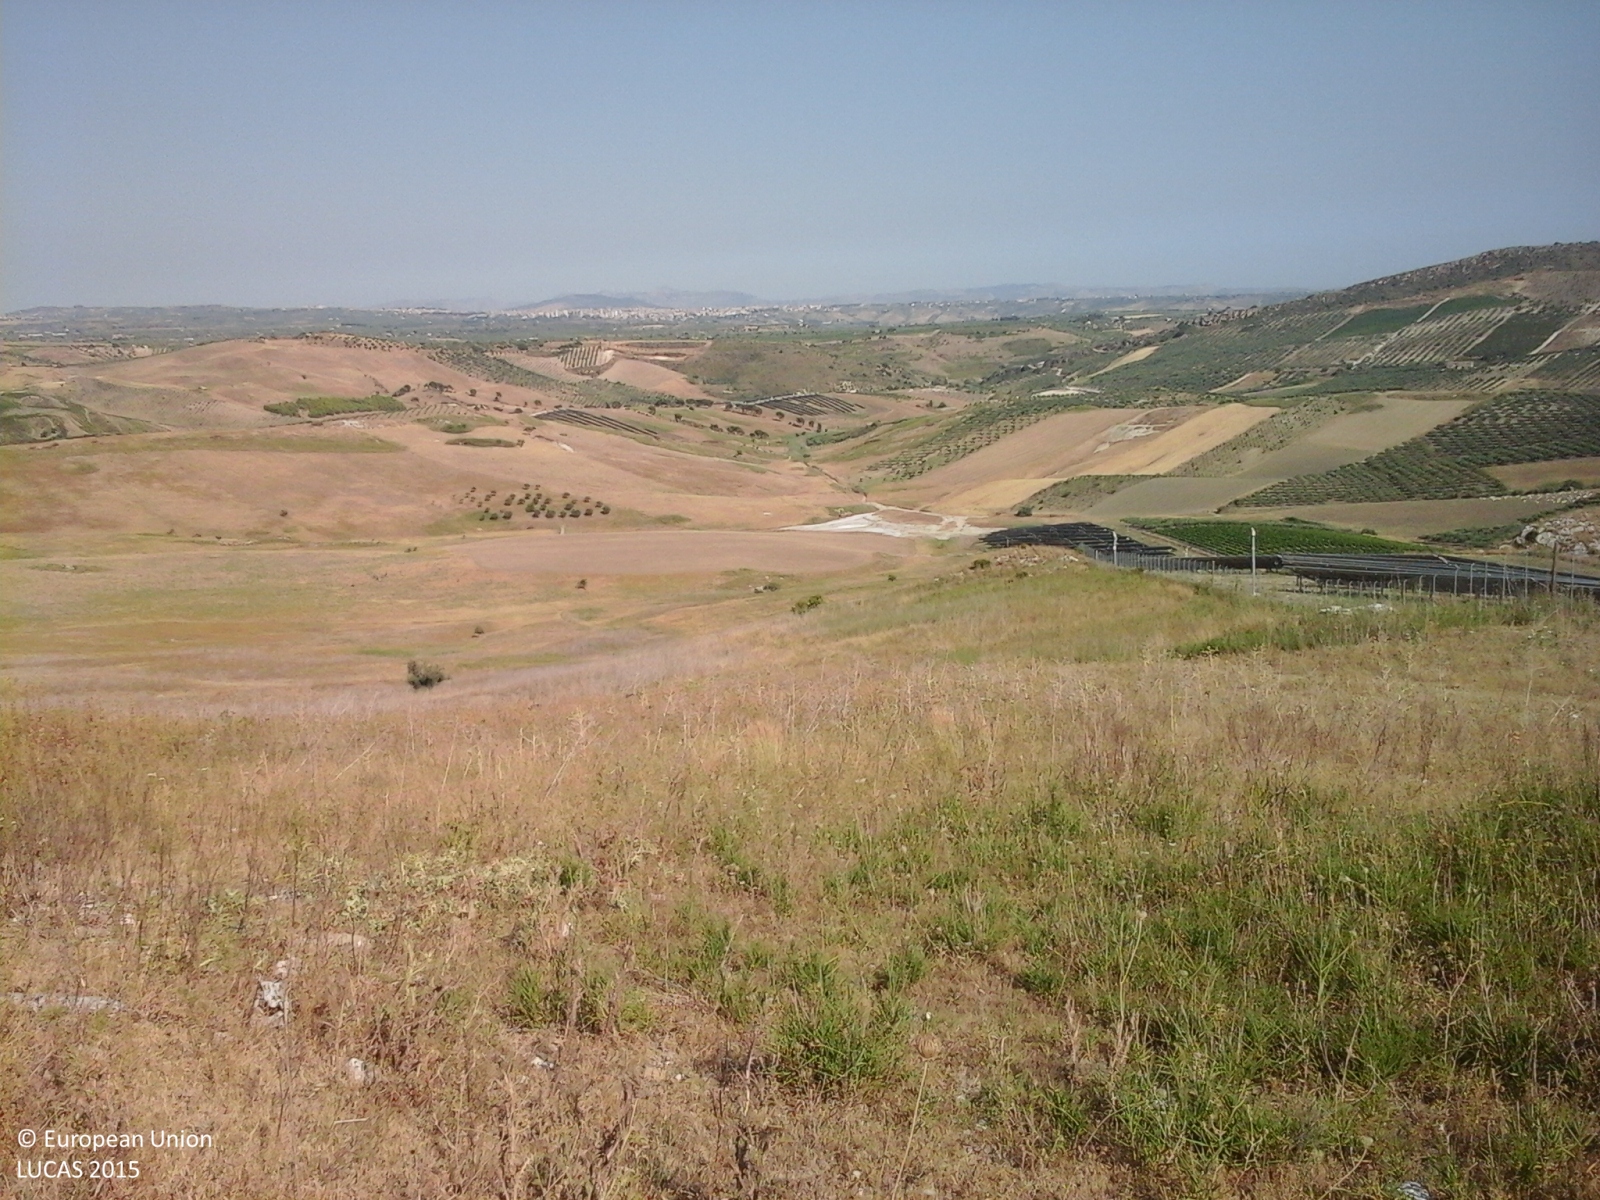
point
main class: Grassland
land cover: Grassland without tree/shrub cover
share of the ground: > 75 %
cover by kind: herbaceous plants 100 %
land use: Agriculture (excluding fallow land and kitchen gardens)
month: July
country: IT
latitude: 37.5309
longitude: 13.1782
